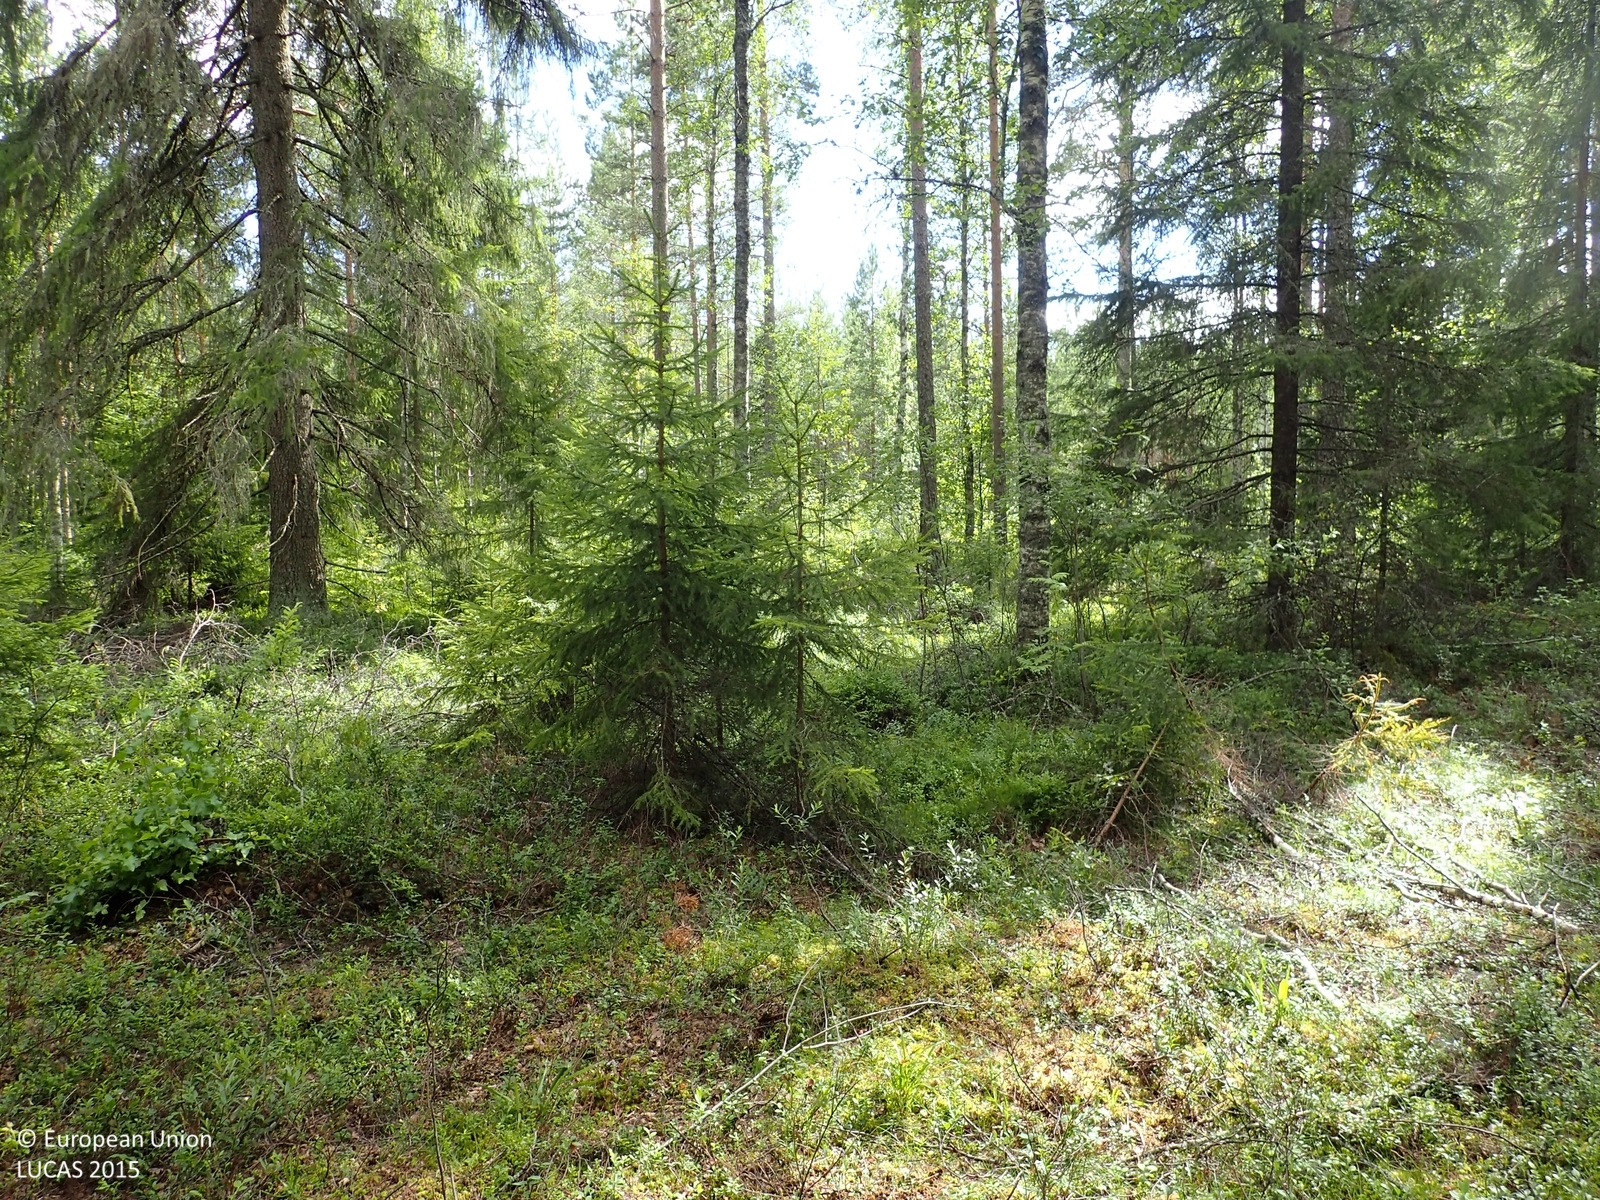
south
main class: Woodland
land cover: Other coniferous woodland
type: boreal forest
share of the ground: > 75 %
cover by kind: coniferous forest trees 70 %, shrubs 20 %, broadleaved forest trees 10 %
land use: Forestry
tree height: > 5 m
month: August
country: FI
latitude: 62.6364
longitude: 21.8447
